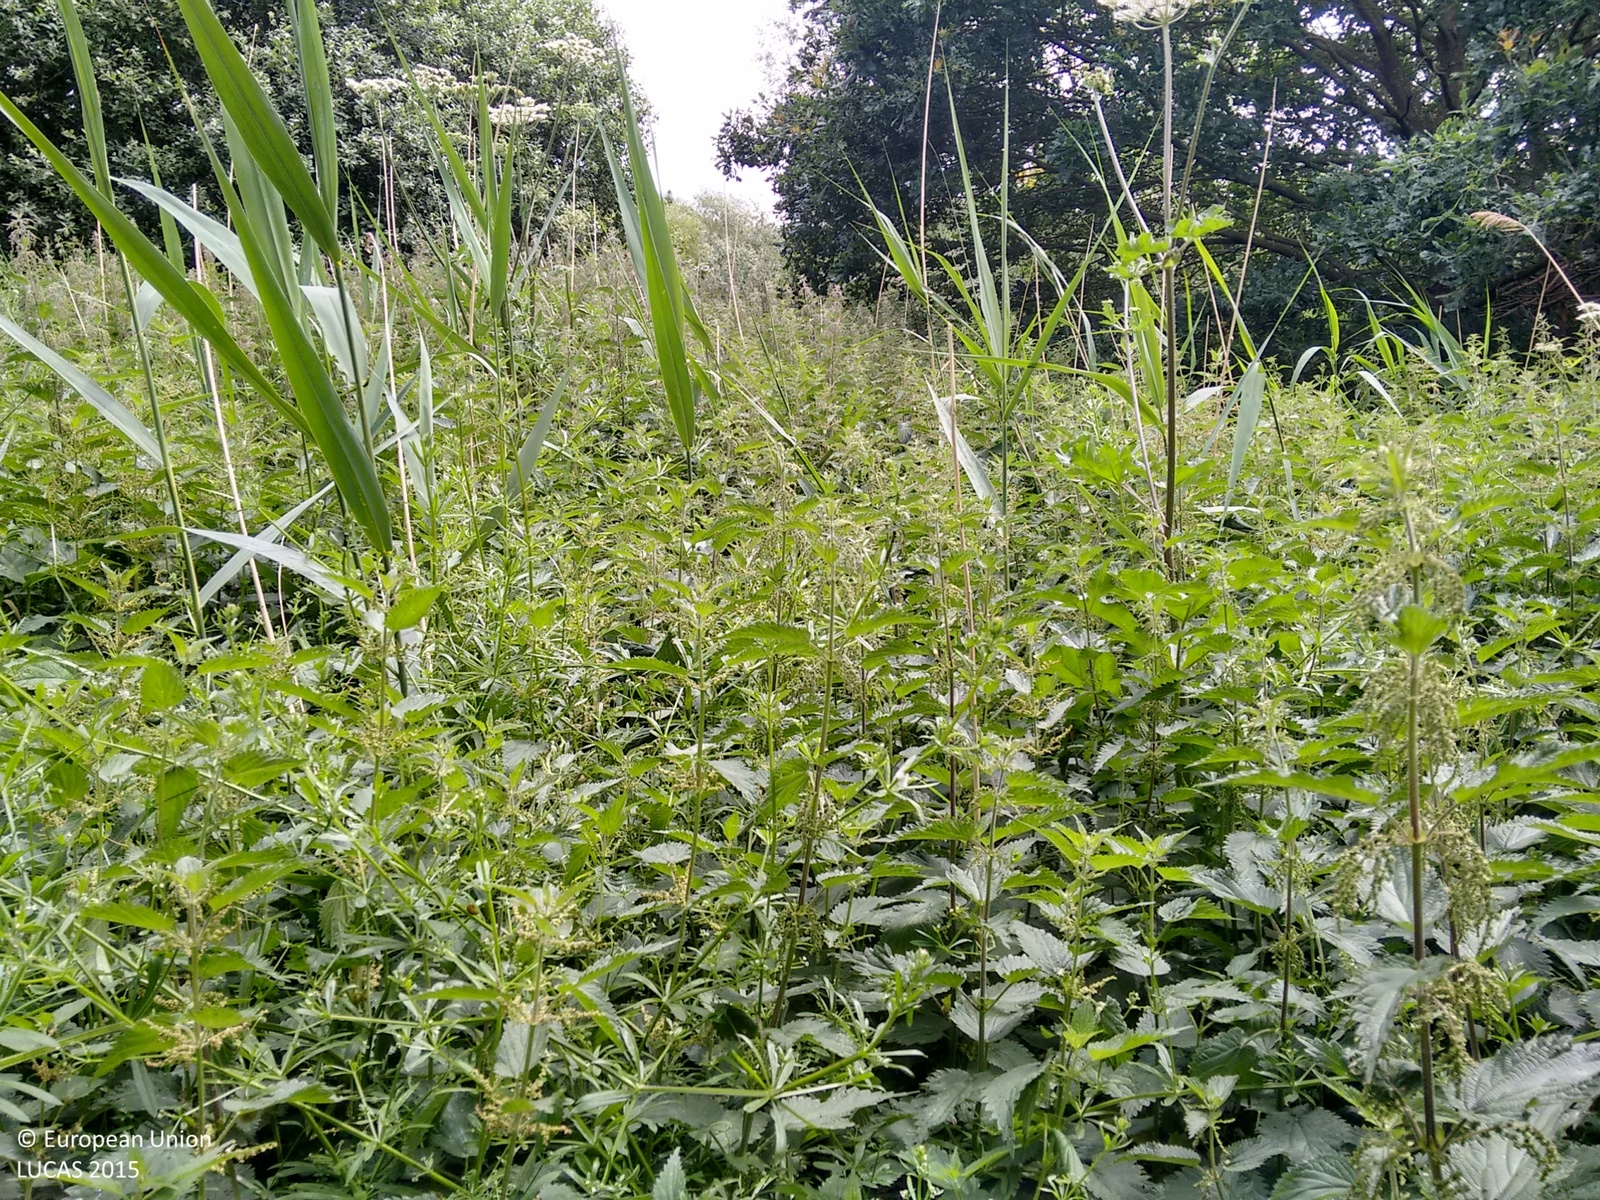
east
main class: Grassland
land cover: Grassland with sparse tree/shrub cover
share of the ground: > 75 %
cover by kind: herbaceous plants 95 %, broadleaved forest trees 5 %
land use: Semi-natural and natural areas not in use
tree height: < 5 m
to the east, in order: Grassland with sparse tree/shrub cover; Inland fresh water bodies; Grassland with sparse tree/shrub cover; Broadleaved woodland; Spontaneously vegetated surfaces; Electric lines; Spontaneously vegetated surfaces; Abandoned hedges; Ditches and canals; Grass margins; Paved roads, cycling and walking lanes; Grassland without tree/shrub cover; Inland fresh running water; Grassland without tree/shrub cover; Common wheat
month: June
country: GB
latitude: 52.5912
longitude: 0.0335
